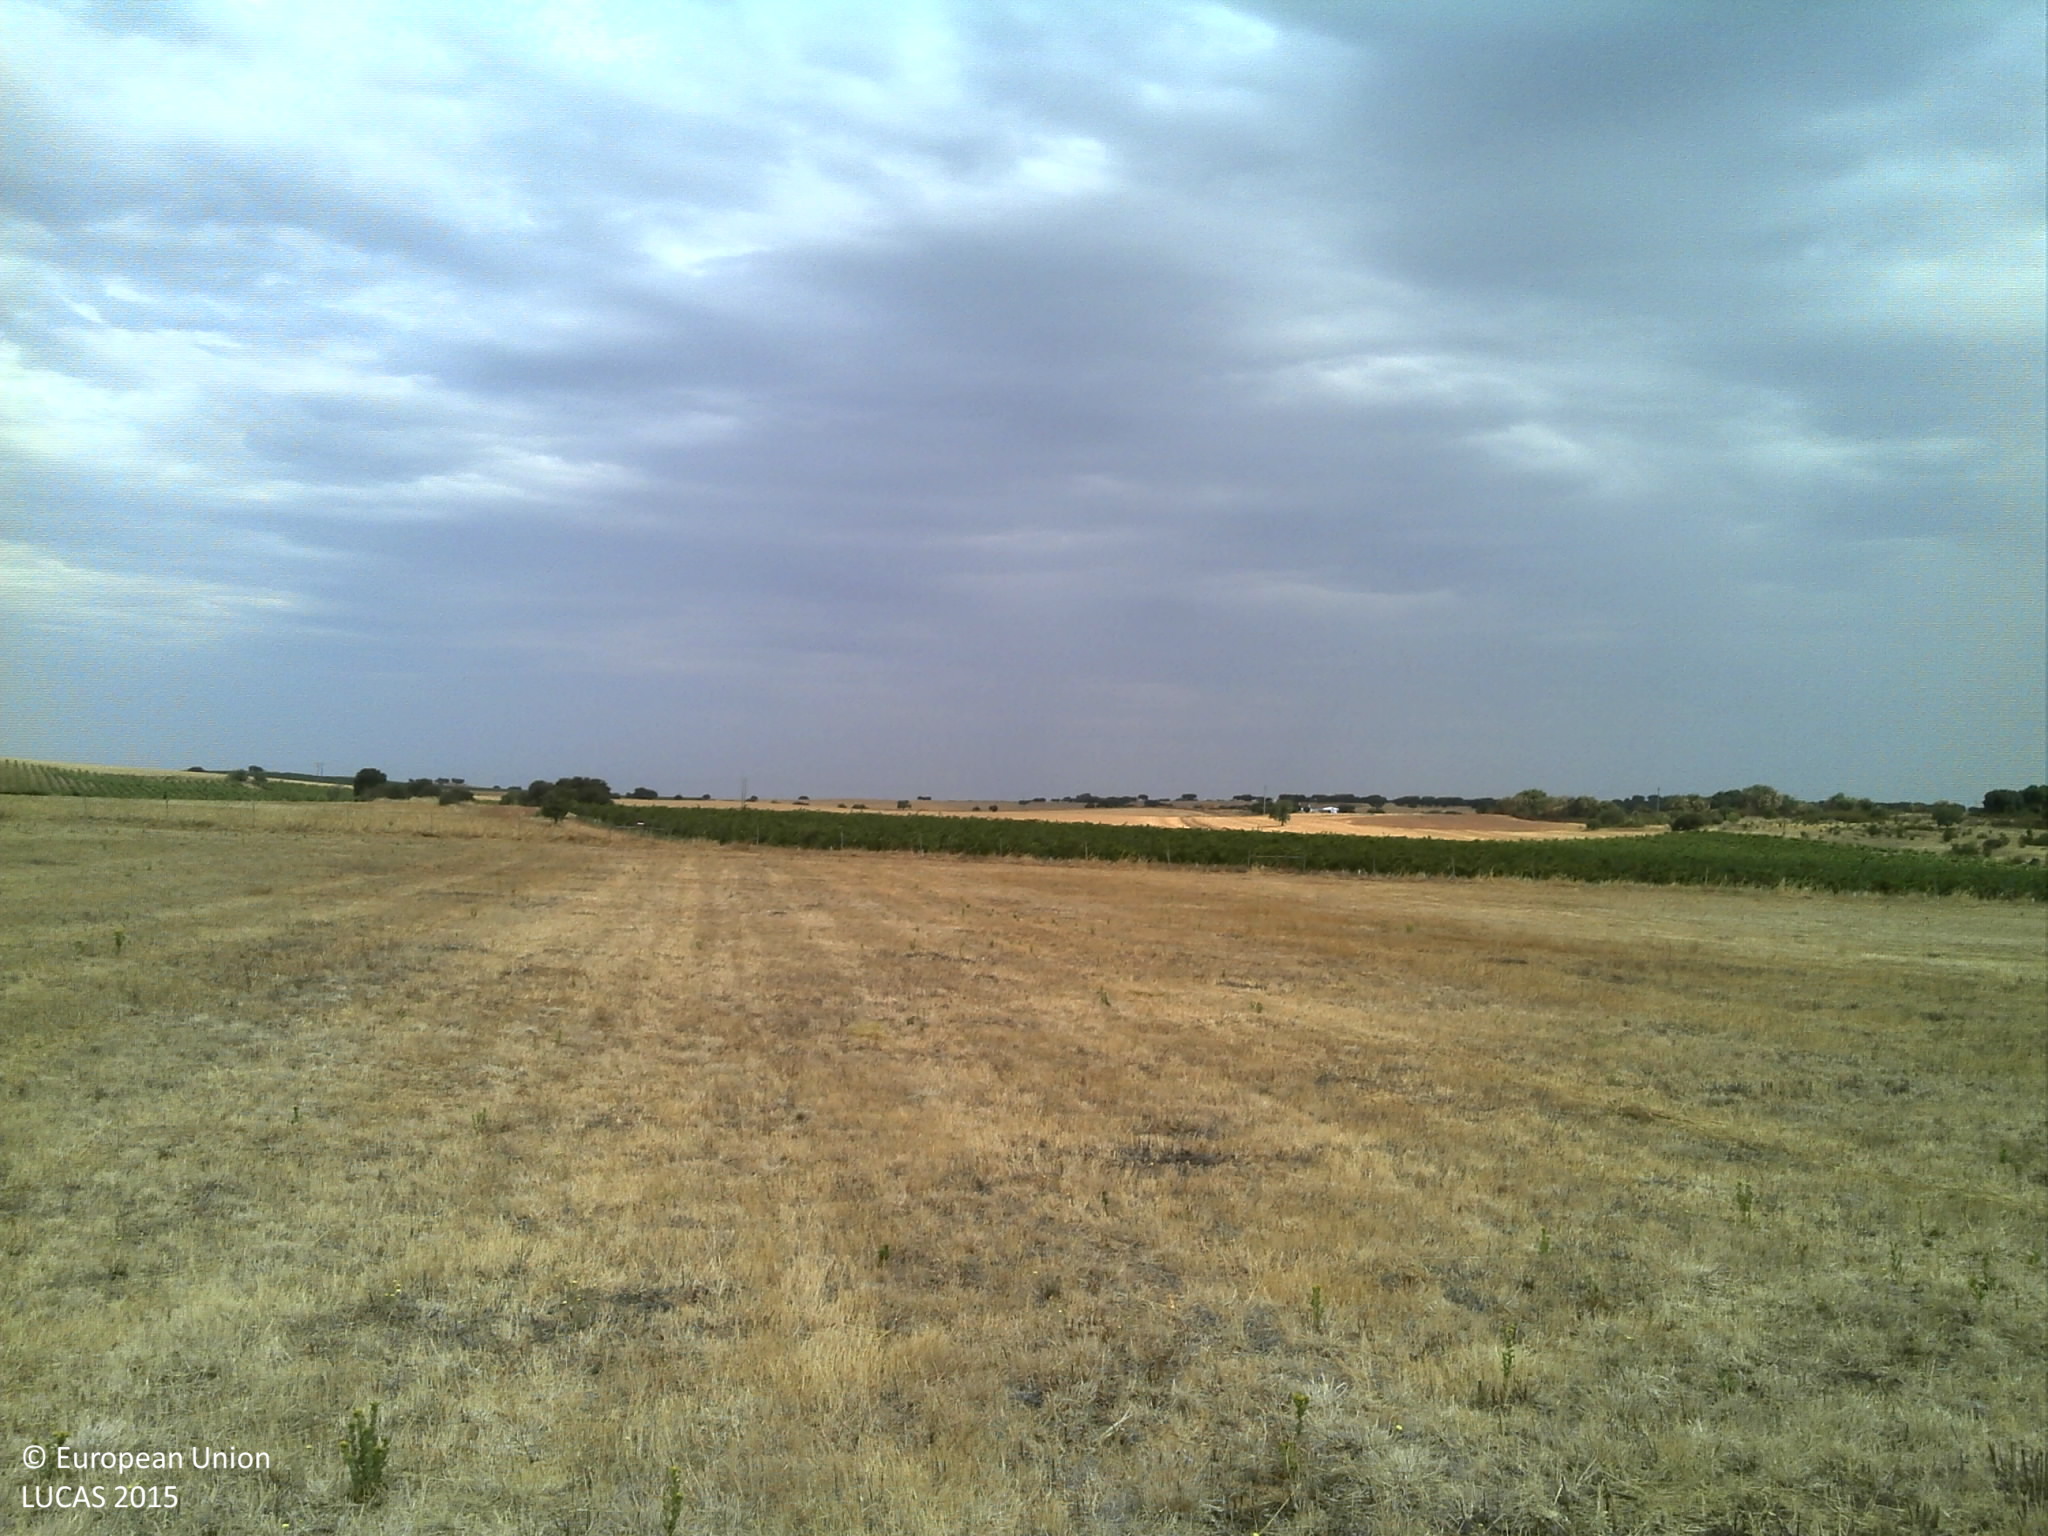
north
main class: Grassland
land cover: Grassland without tree/shrub cover
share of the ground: 25 - 50 %
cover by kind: unconsolidated bare surface 60 %, herbaceous plants 40 %
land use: Agriculture (excluding fallow land and kitchen gardens)
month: July
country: PT
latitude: 38.8432
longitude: -7.4187
